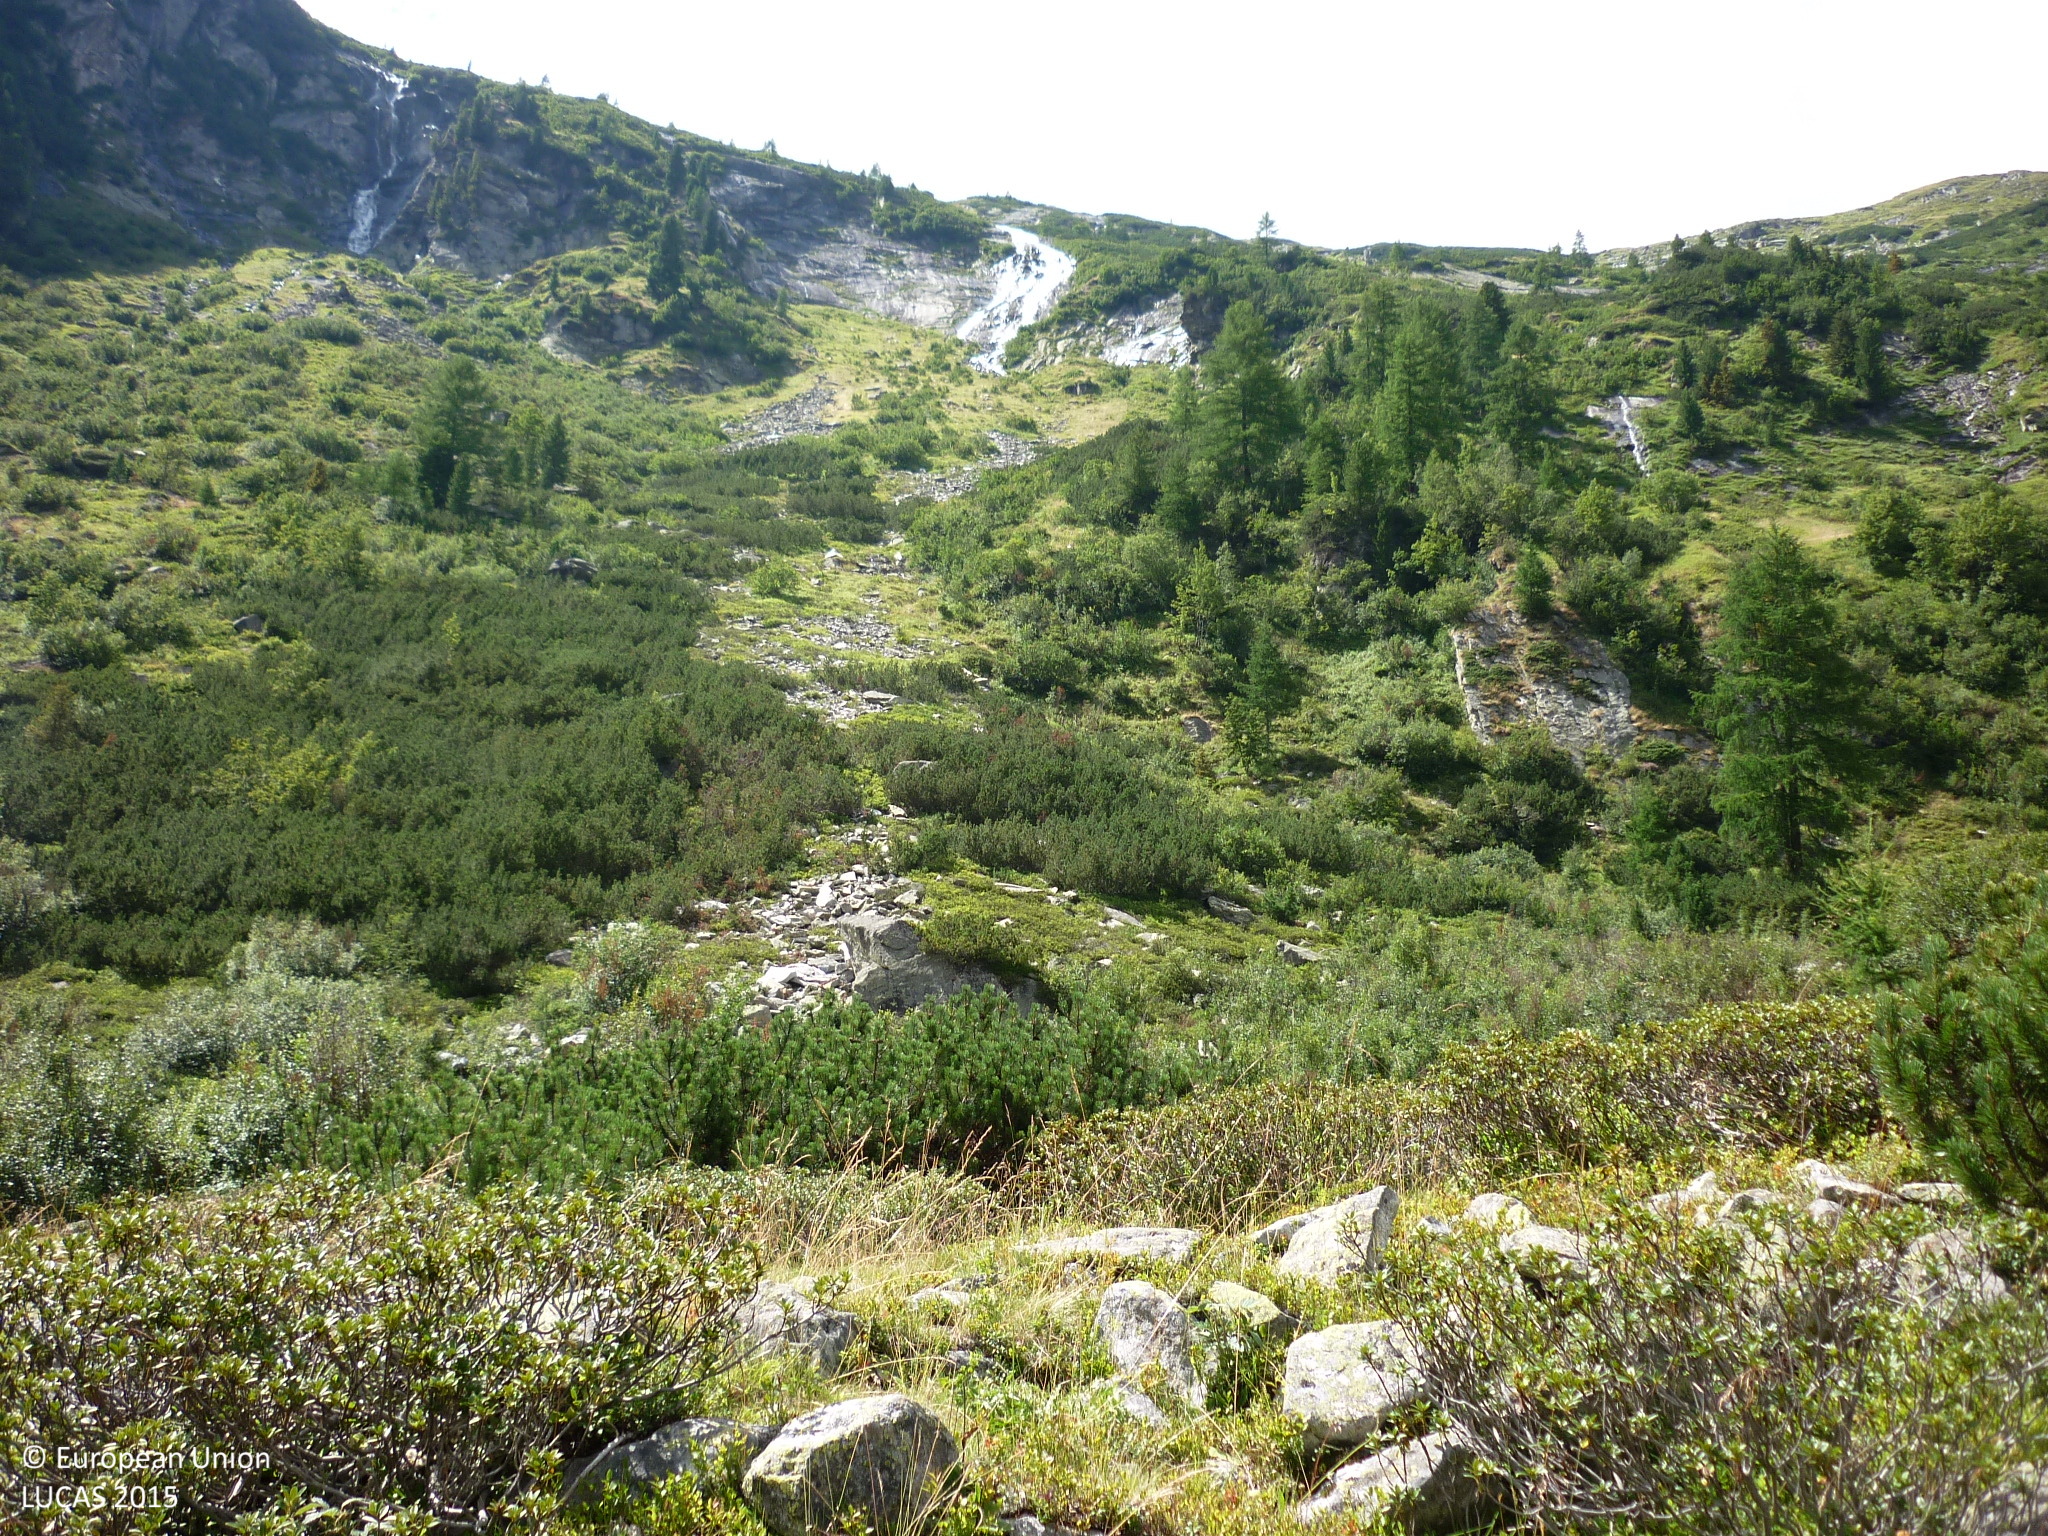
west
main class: Shrubland
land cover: Shrubland with sparse tree cover
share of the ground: > 75 %
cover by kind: consolidated bare surface 40 %, shrubs 30 %, herbaceous plants 15 %, lichens and mosses 10 %, coniferous forest trees 5 %
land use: Agriculture (excluding fallow land and kitchen gardens)
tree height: < 5 m
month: August
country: AT
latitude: 46.9845
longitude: 13.3239
